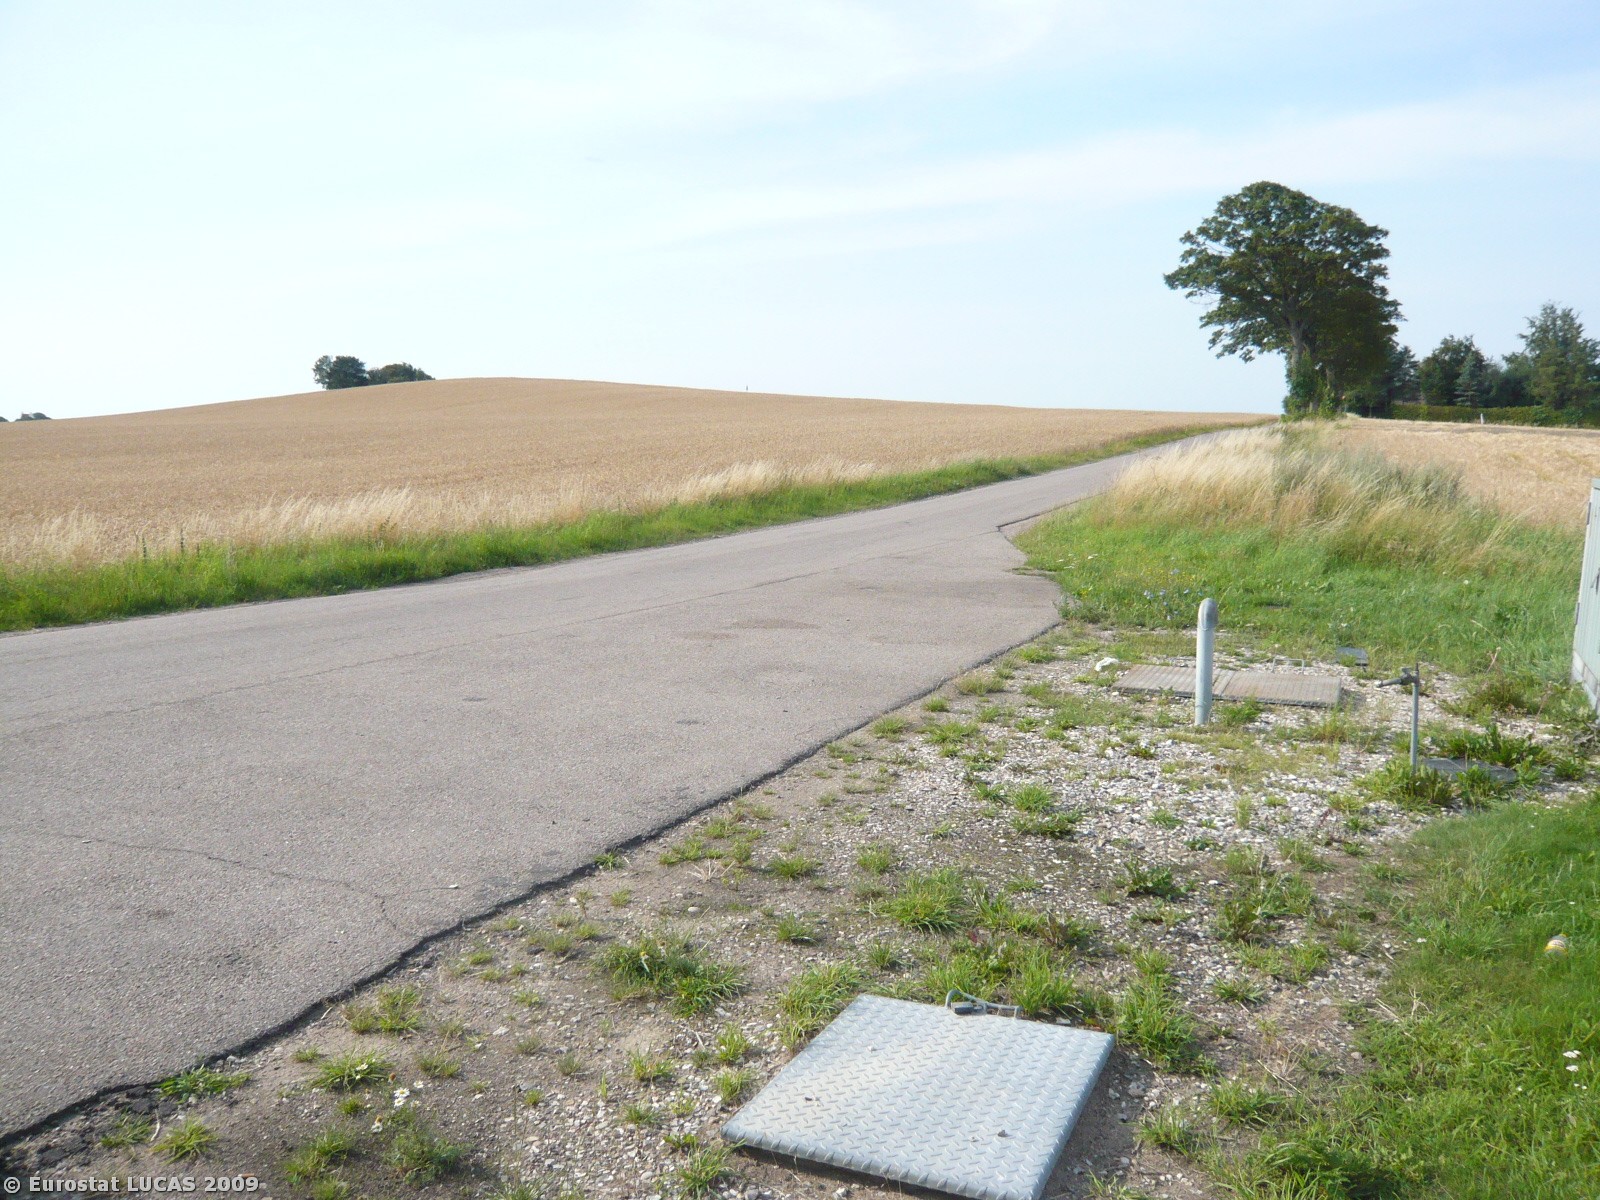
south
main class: Cropland
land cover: Barley
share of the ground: > 75 %
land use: Agriculture (excluding fallow land and kitchen gardens)
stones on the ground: < 10 %
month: August
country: DK
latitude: 55.9897
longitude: 12.1620
